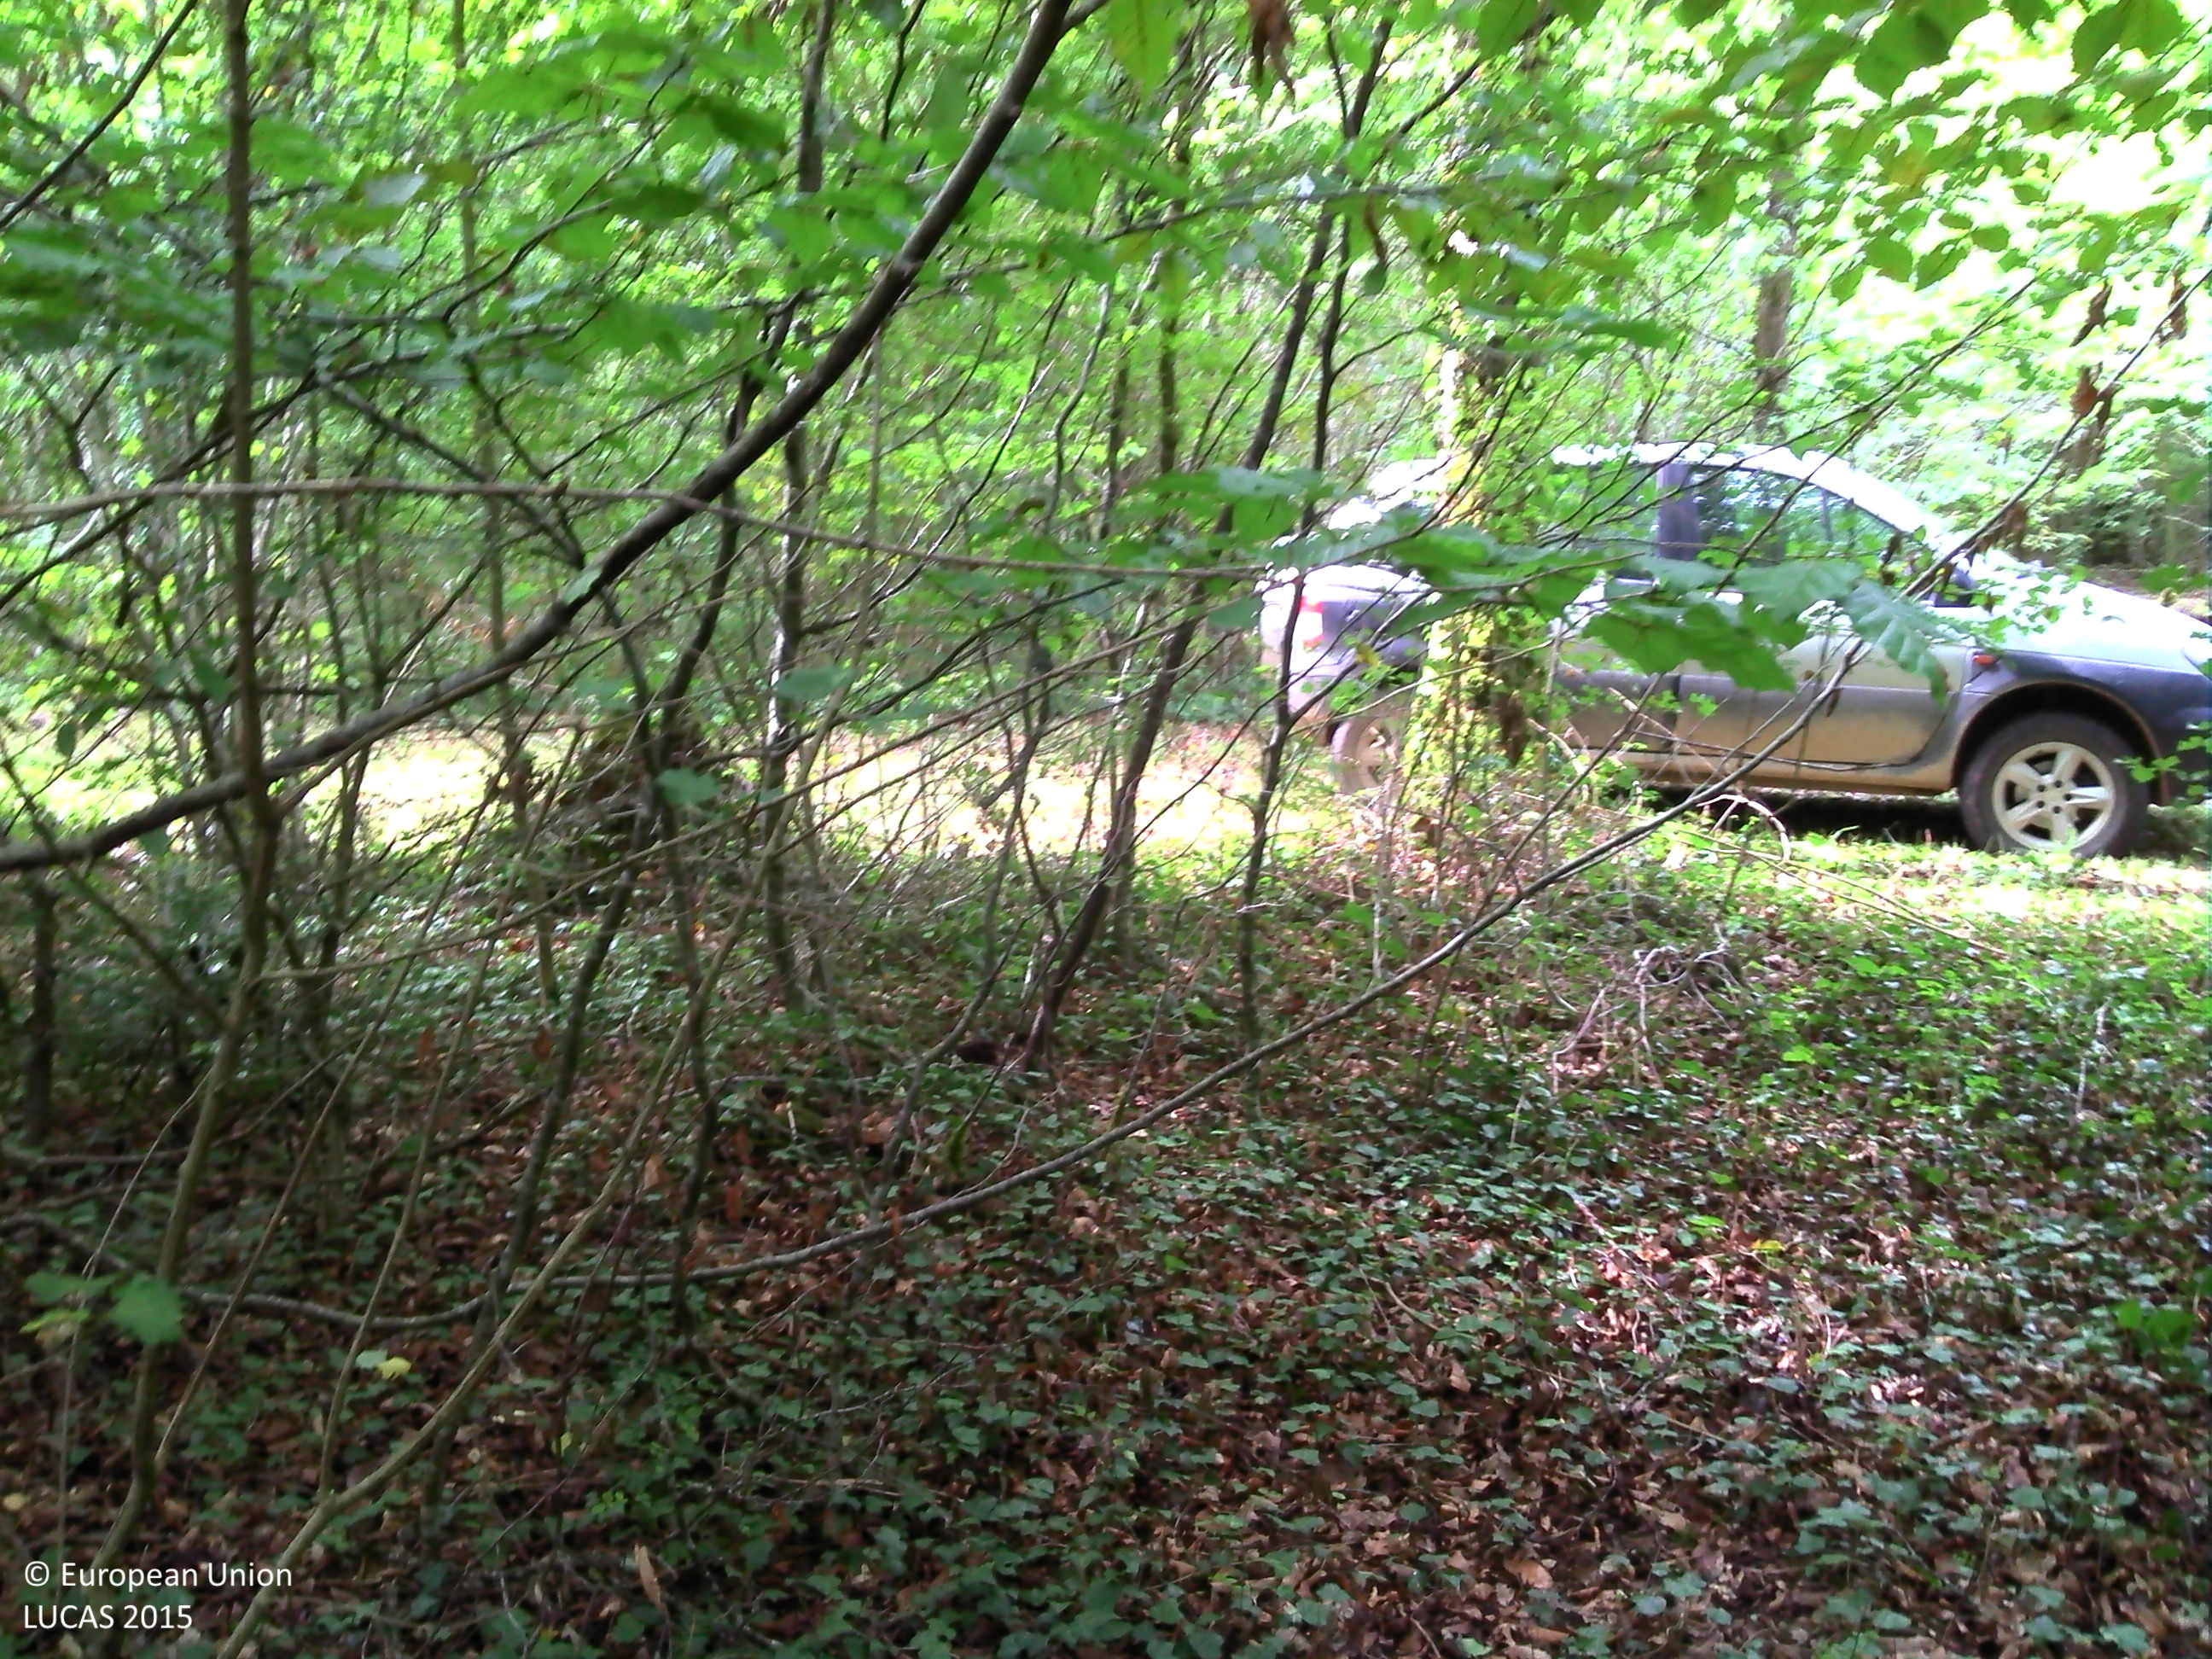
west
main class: Woodland
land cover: Broadleaved woodland
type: mesophytic deciduous forest
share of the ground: > 75 %
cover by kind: broadleaved forest trees 90 %, herbaceous plants 5 %, lichens and mosses 5 %
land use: Forestry
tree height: > 5 m
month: September
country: FR
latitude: 48.2547
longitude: 4.6238
